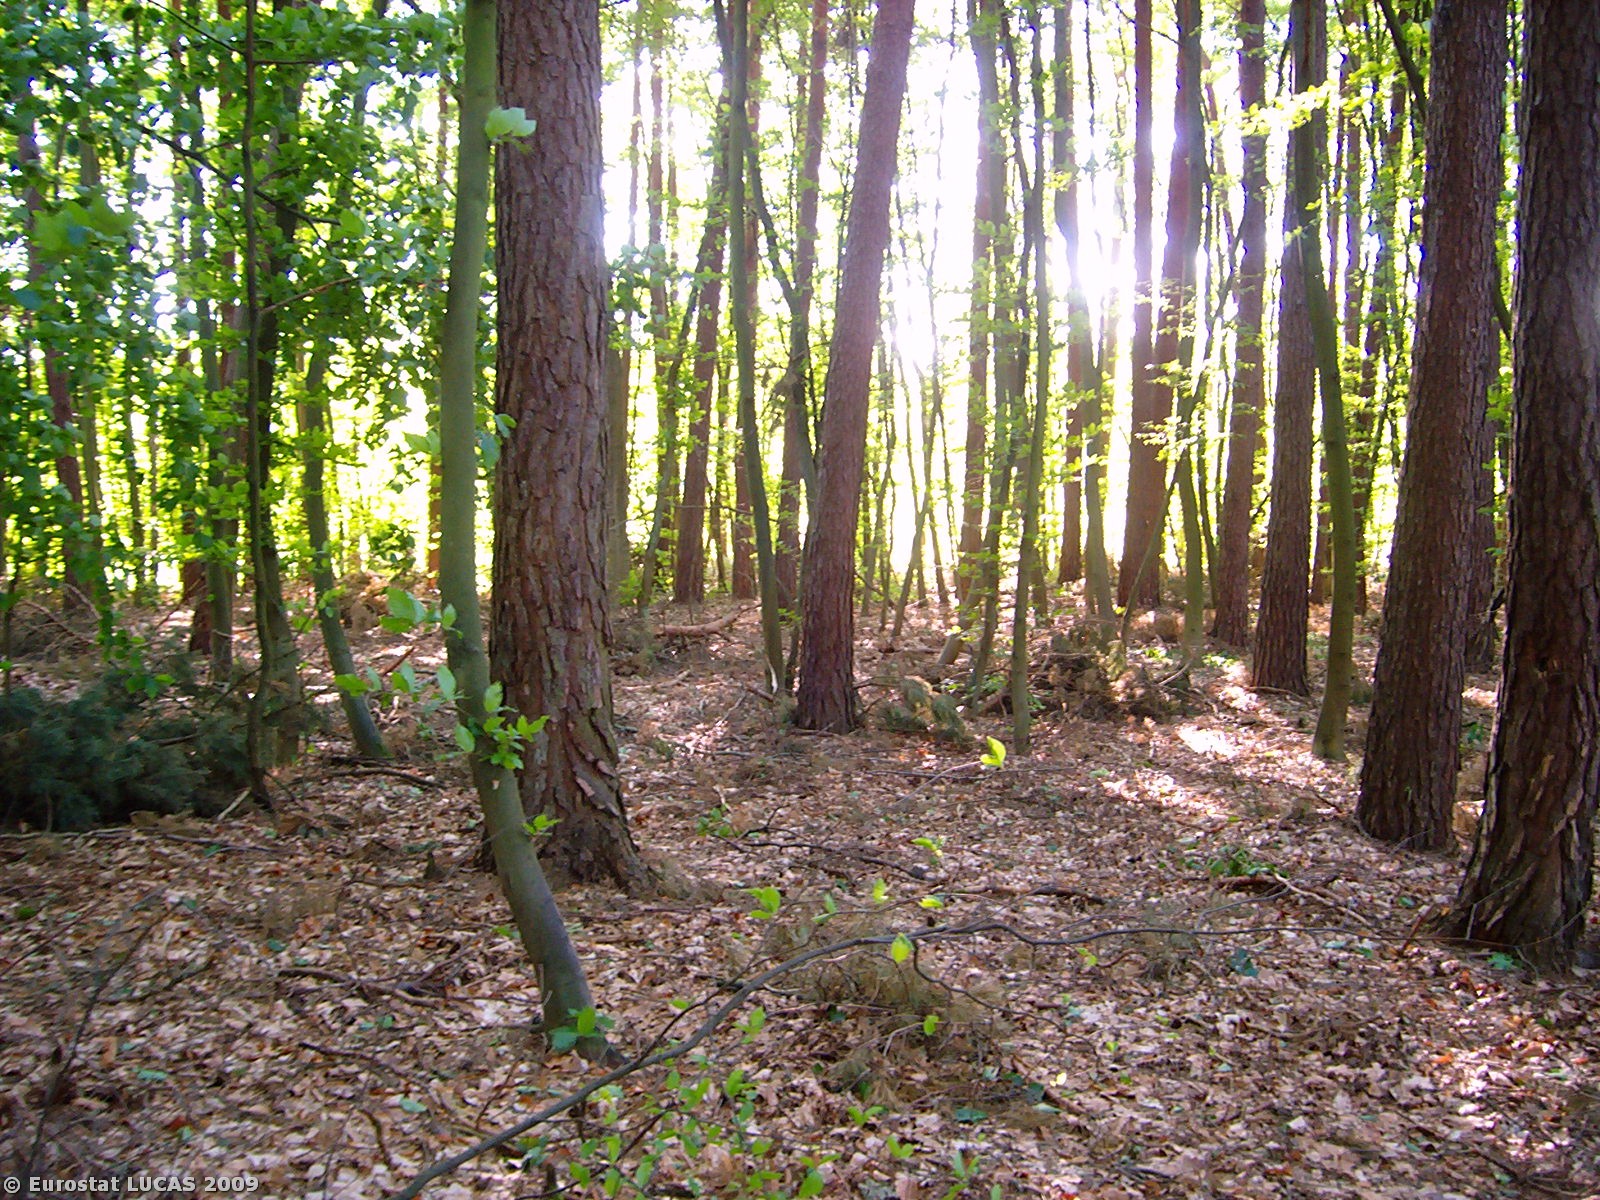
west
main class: Woodland
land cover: Mixed woodland
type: hemiboreal forest and nemoral coniferous forest and mixed broadleaved-coniferous forest
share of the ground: > 75 %
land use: Forestry
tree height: > 5 m
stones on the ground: < 10 %
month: June
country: PL
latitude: 53.7644
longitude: 15.4794
